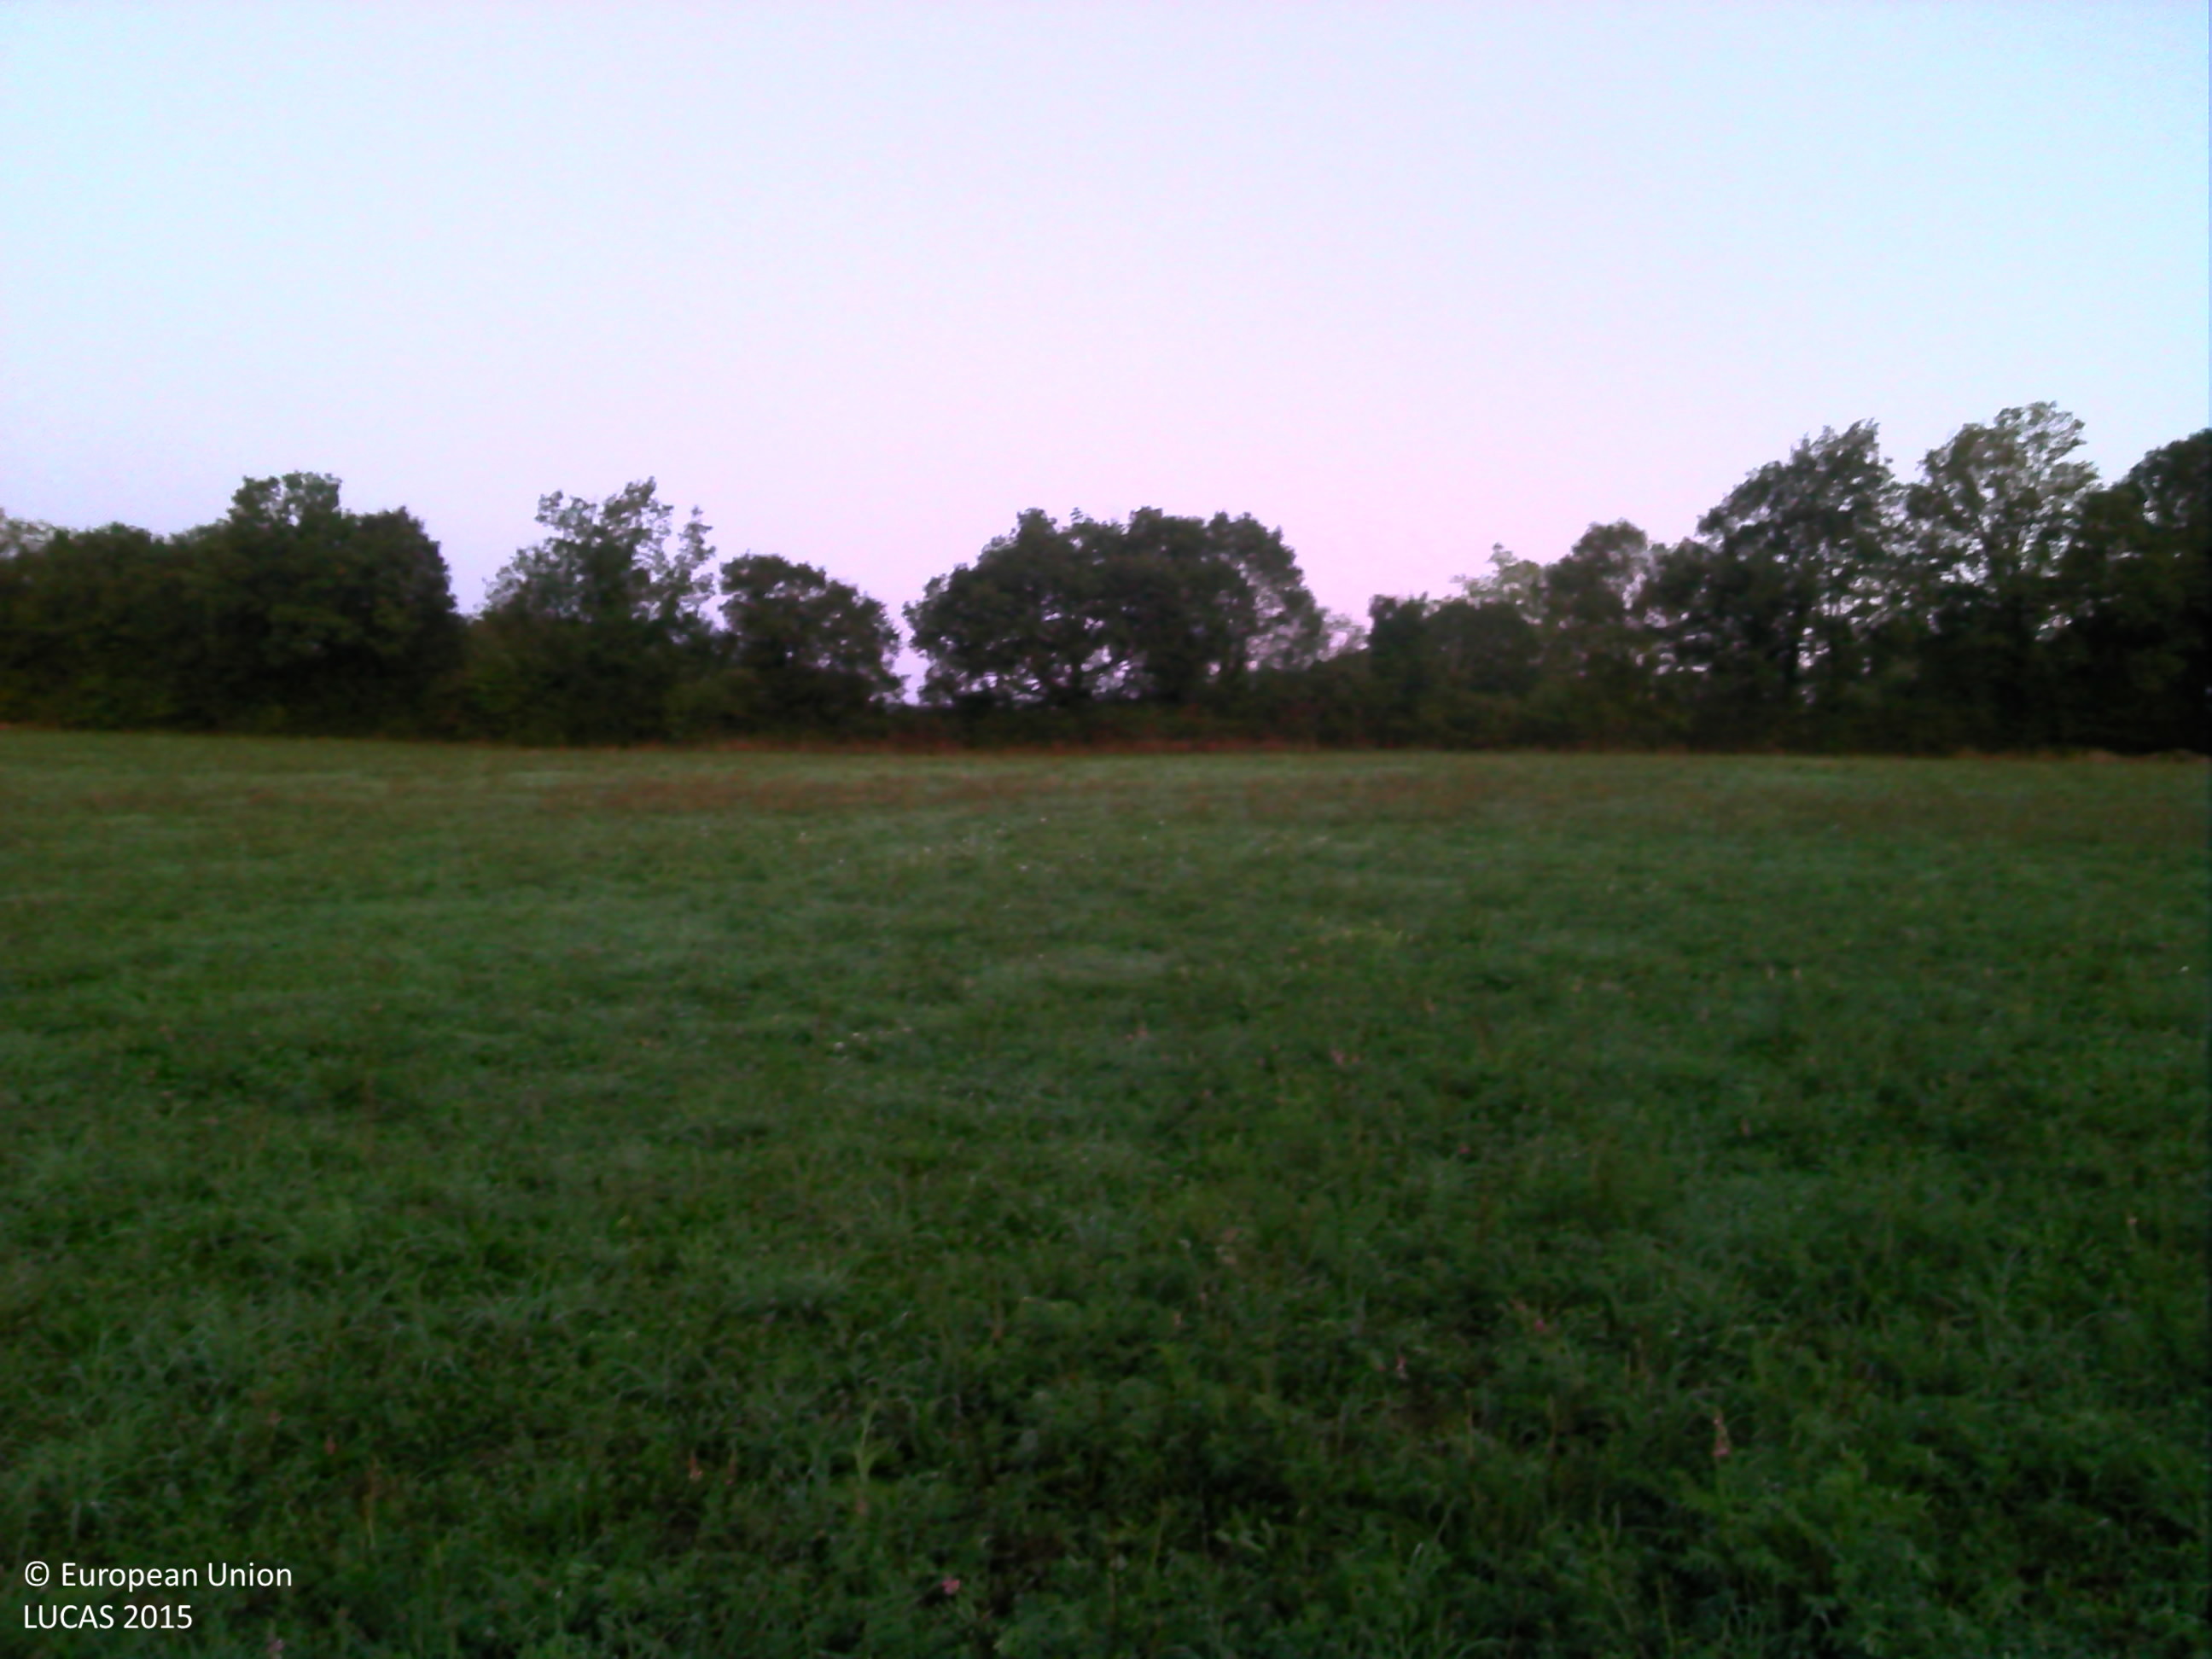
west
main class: Grassland
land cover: Grassland without tree/shrub cover
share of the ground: > 75 %
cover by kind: herbaceous plants 100 %
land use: Agriculture (excluding fallow land and kitchen gardens)
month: September
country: FR
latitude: 44.6787
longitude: 1.5832
